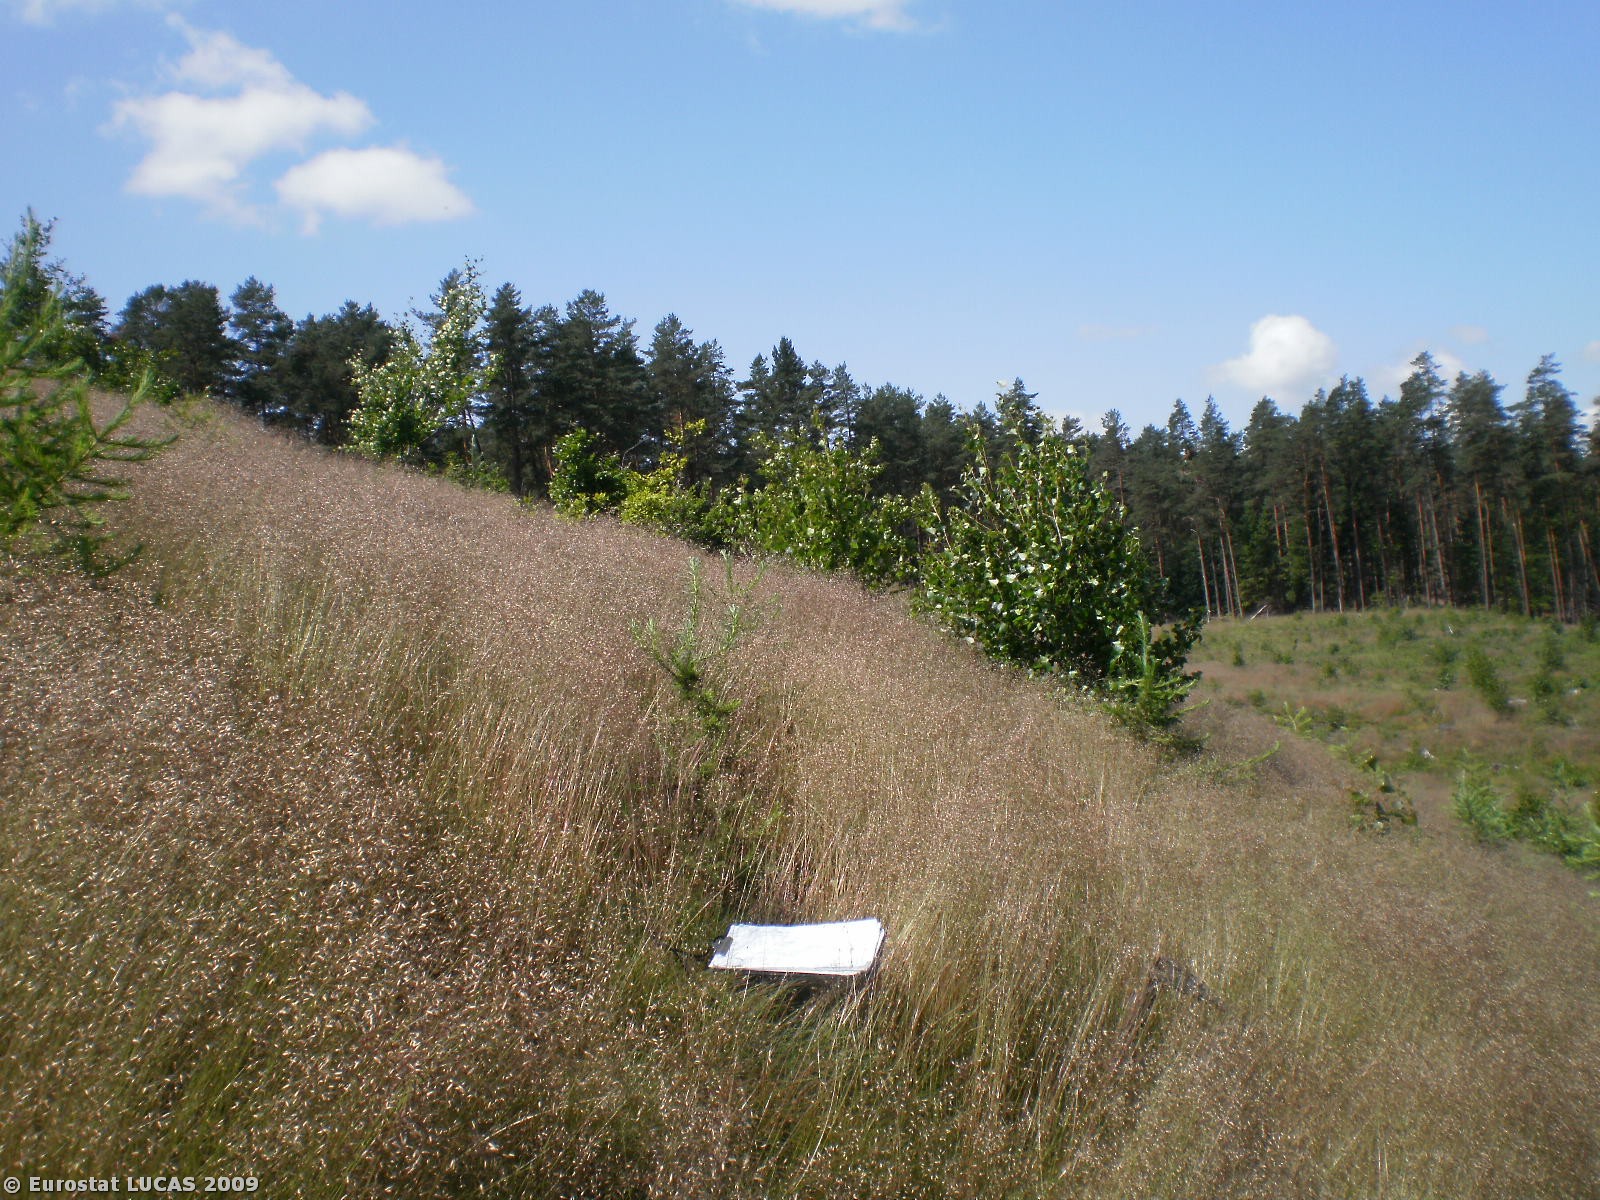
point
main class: Grassland
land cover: Grassland with sparse tree/shrub cover
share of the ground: > 75 %
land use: Forestry
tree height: > 5 m
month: July
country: PL
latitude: 54.2306
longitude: 17.2657
